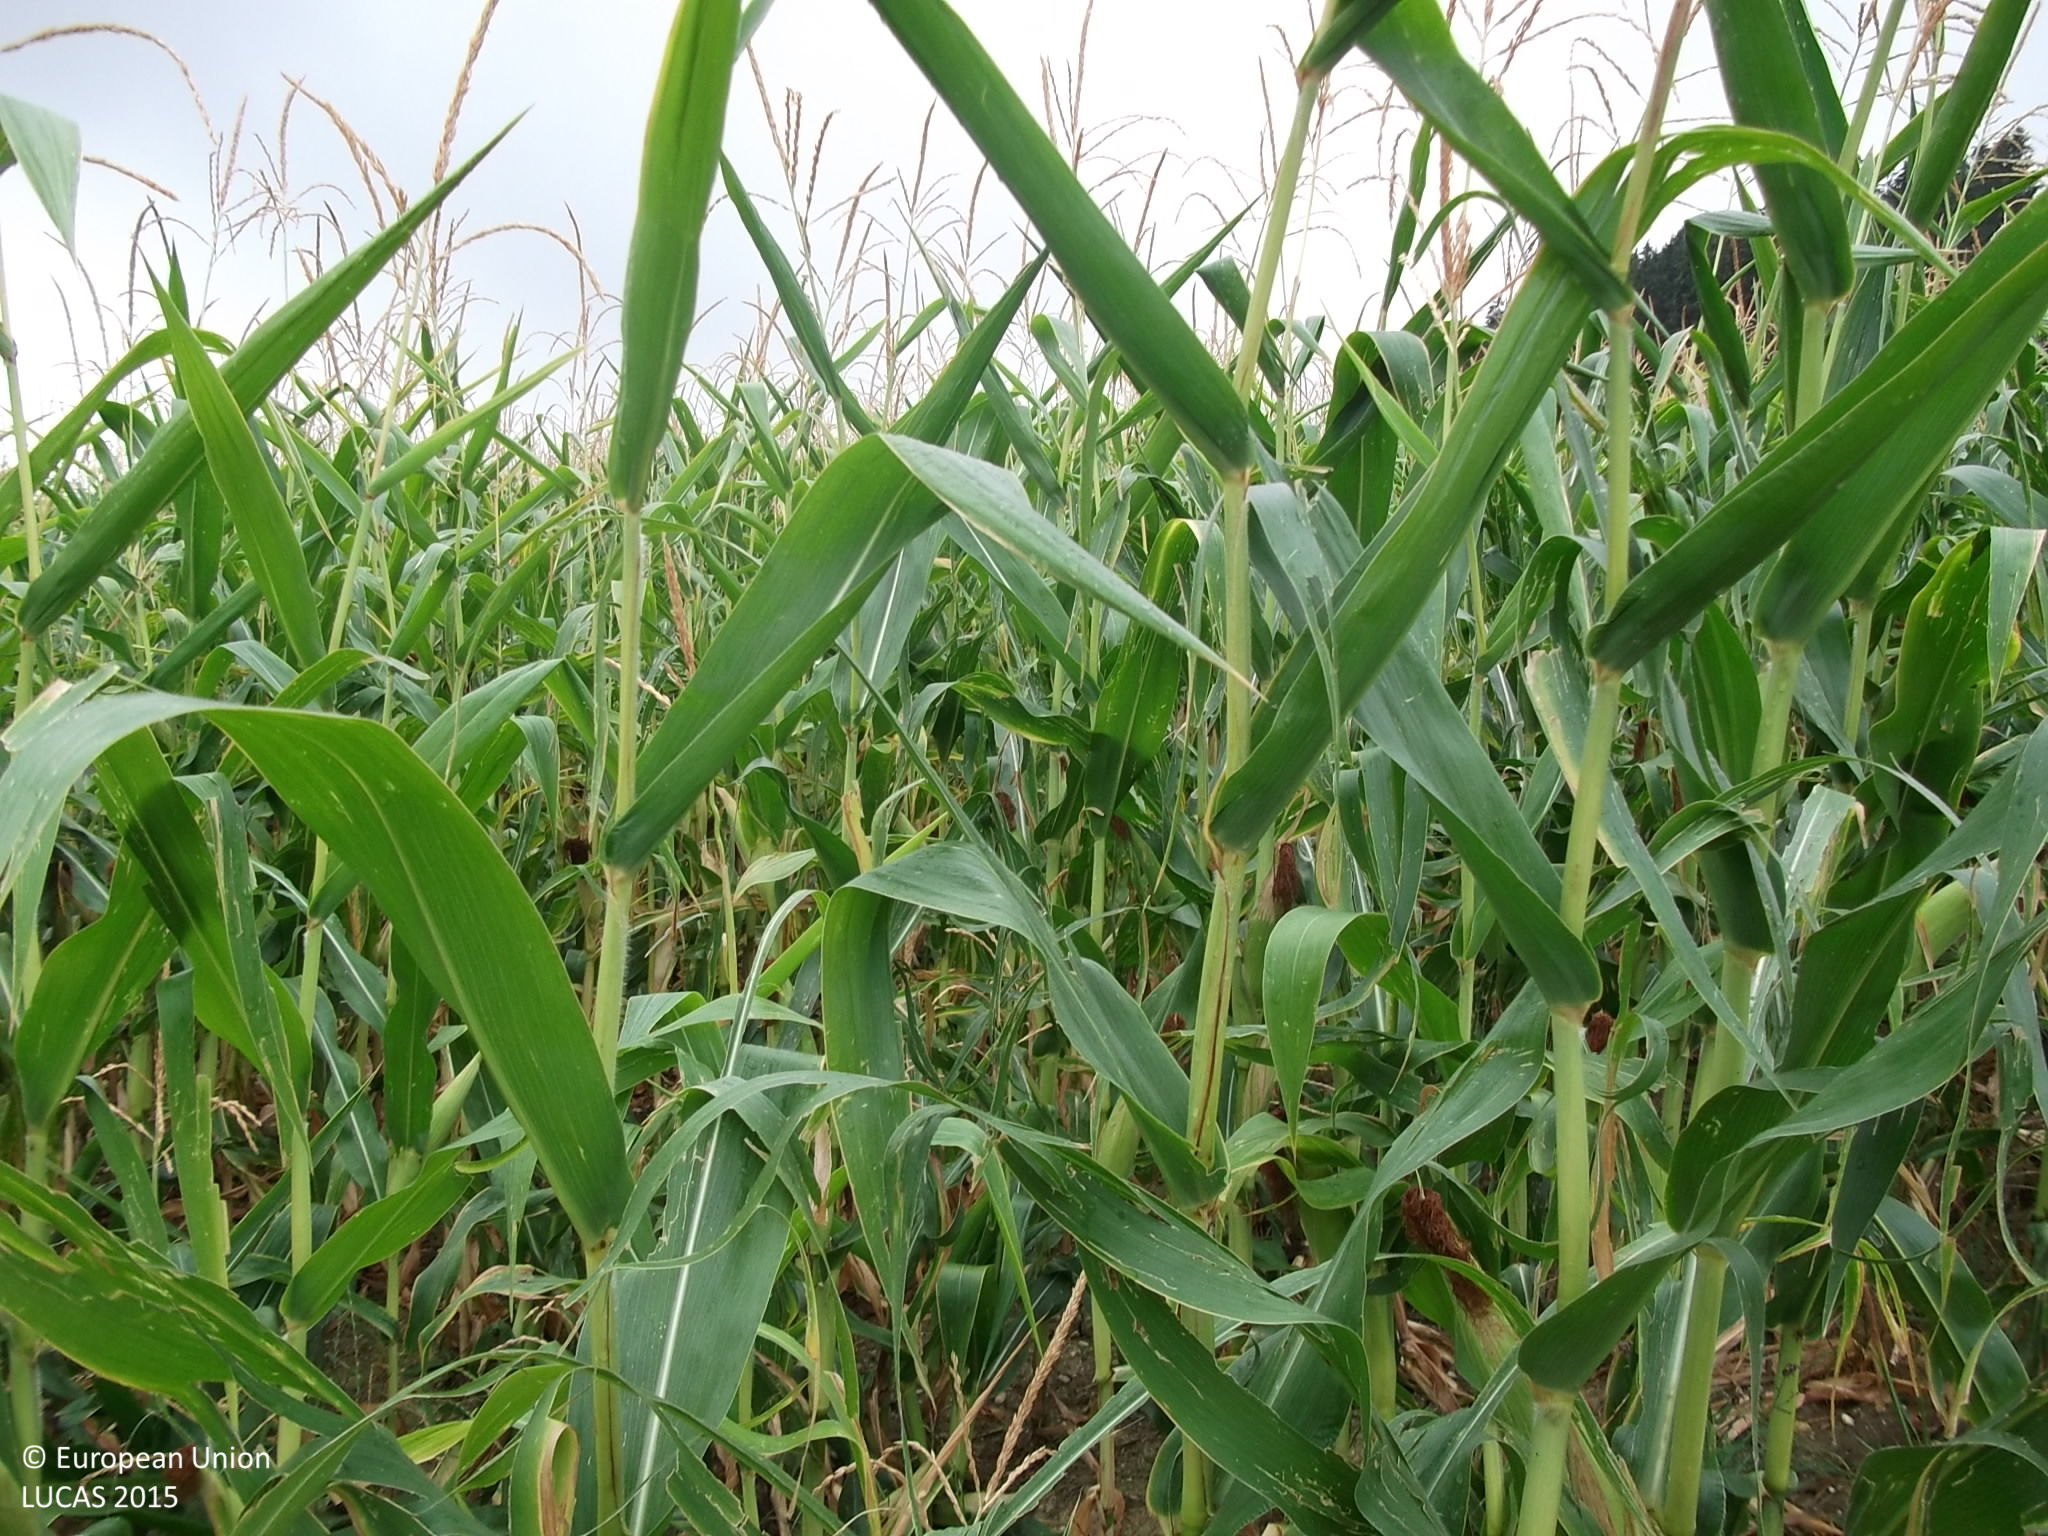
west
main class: Cropland
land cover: Maize
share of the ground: > 75 %
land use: Agriculture (excluding fallow land and kitchen gardens)
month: August
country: AT
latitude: 48.2446
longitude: 13.3523
